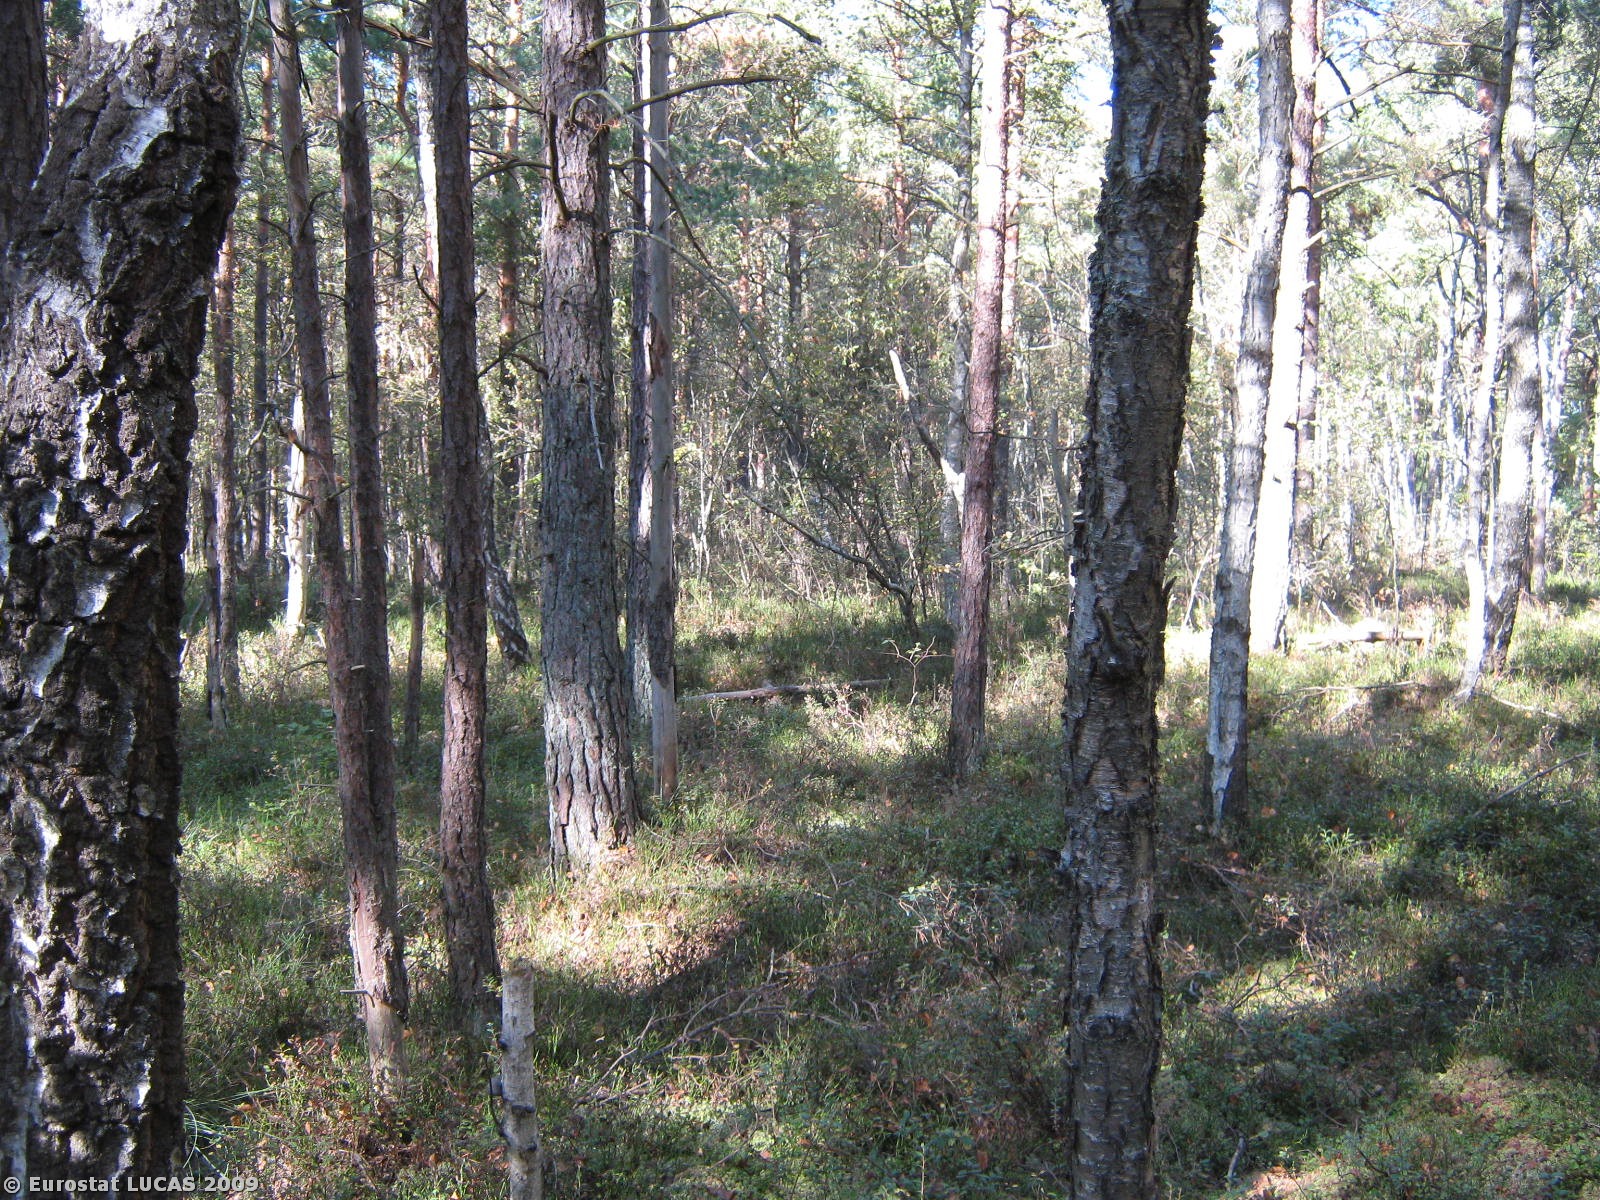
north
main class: Woodland
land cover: Mixed woodland
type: hemiboreal forest and nemoral coniferous forest and mixed broadleaved-coniferous forest
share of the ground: 50 - 75 %
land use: Forestry
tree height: > 5 m
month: September
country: PL
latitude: 53.8505
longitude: 16.6500
